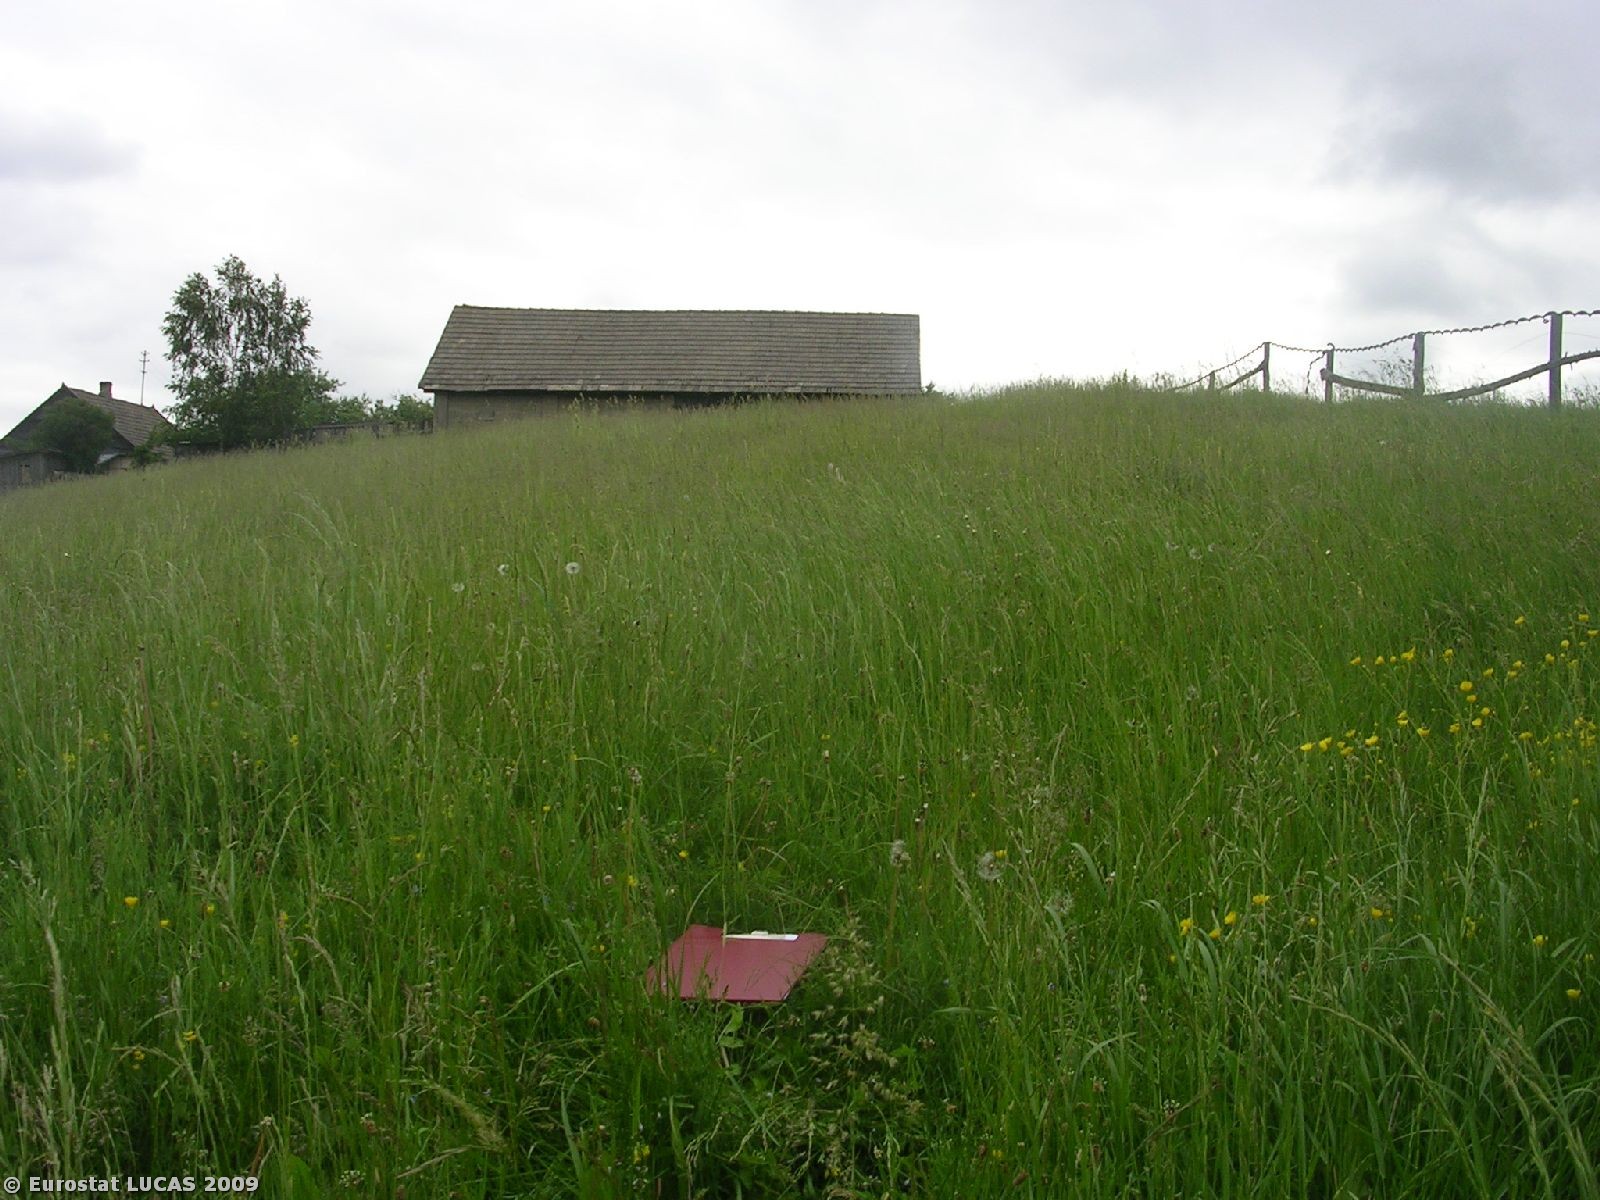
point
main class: Grassland
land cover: Grassland without tree/shrub cover
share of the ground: > 75 %
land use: Agriculture (excluding fallow land and kitchen gardens)
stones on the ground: < 10 %
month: June
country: PL
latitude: 53.4079
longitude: 23.3332
